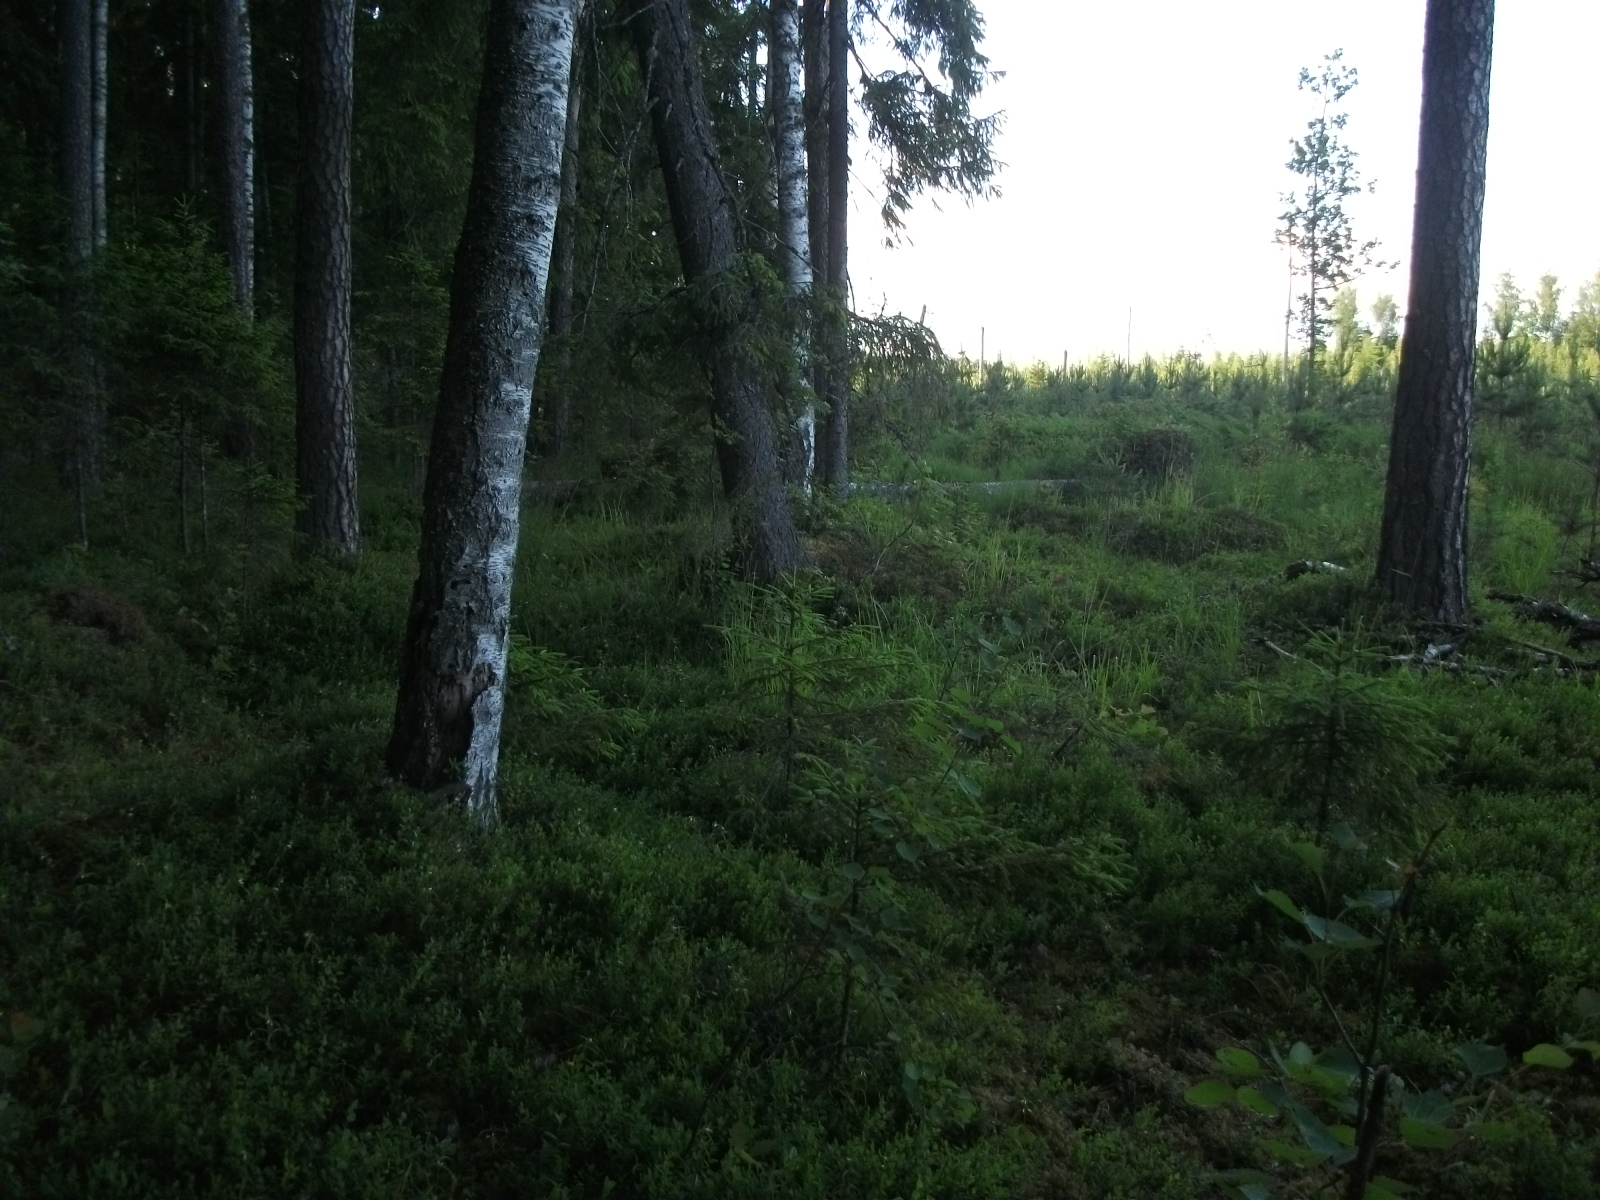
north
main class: Woodland
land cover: Other coniferous woodland
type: hemiboreal forest and nemoral coniferous forest and mixed broadleaved-coniferous forest
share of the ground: > 75 %
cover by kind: coniferous forest trees 80 %, broadleaved forest trees 5 %, shrubs 5 %, herbaceous plants 5 %, lichens and mosses 5 %
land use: Forestry
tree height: > 5 m
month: June
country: LV
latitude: 56.9230
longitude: 26.5598
